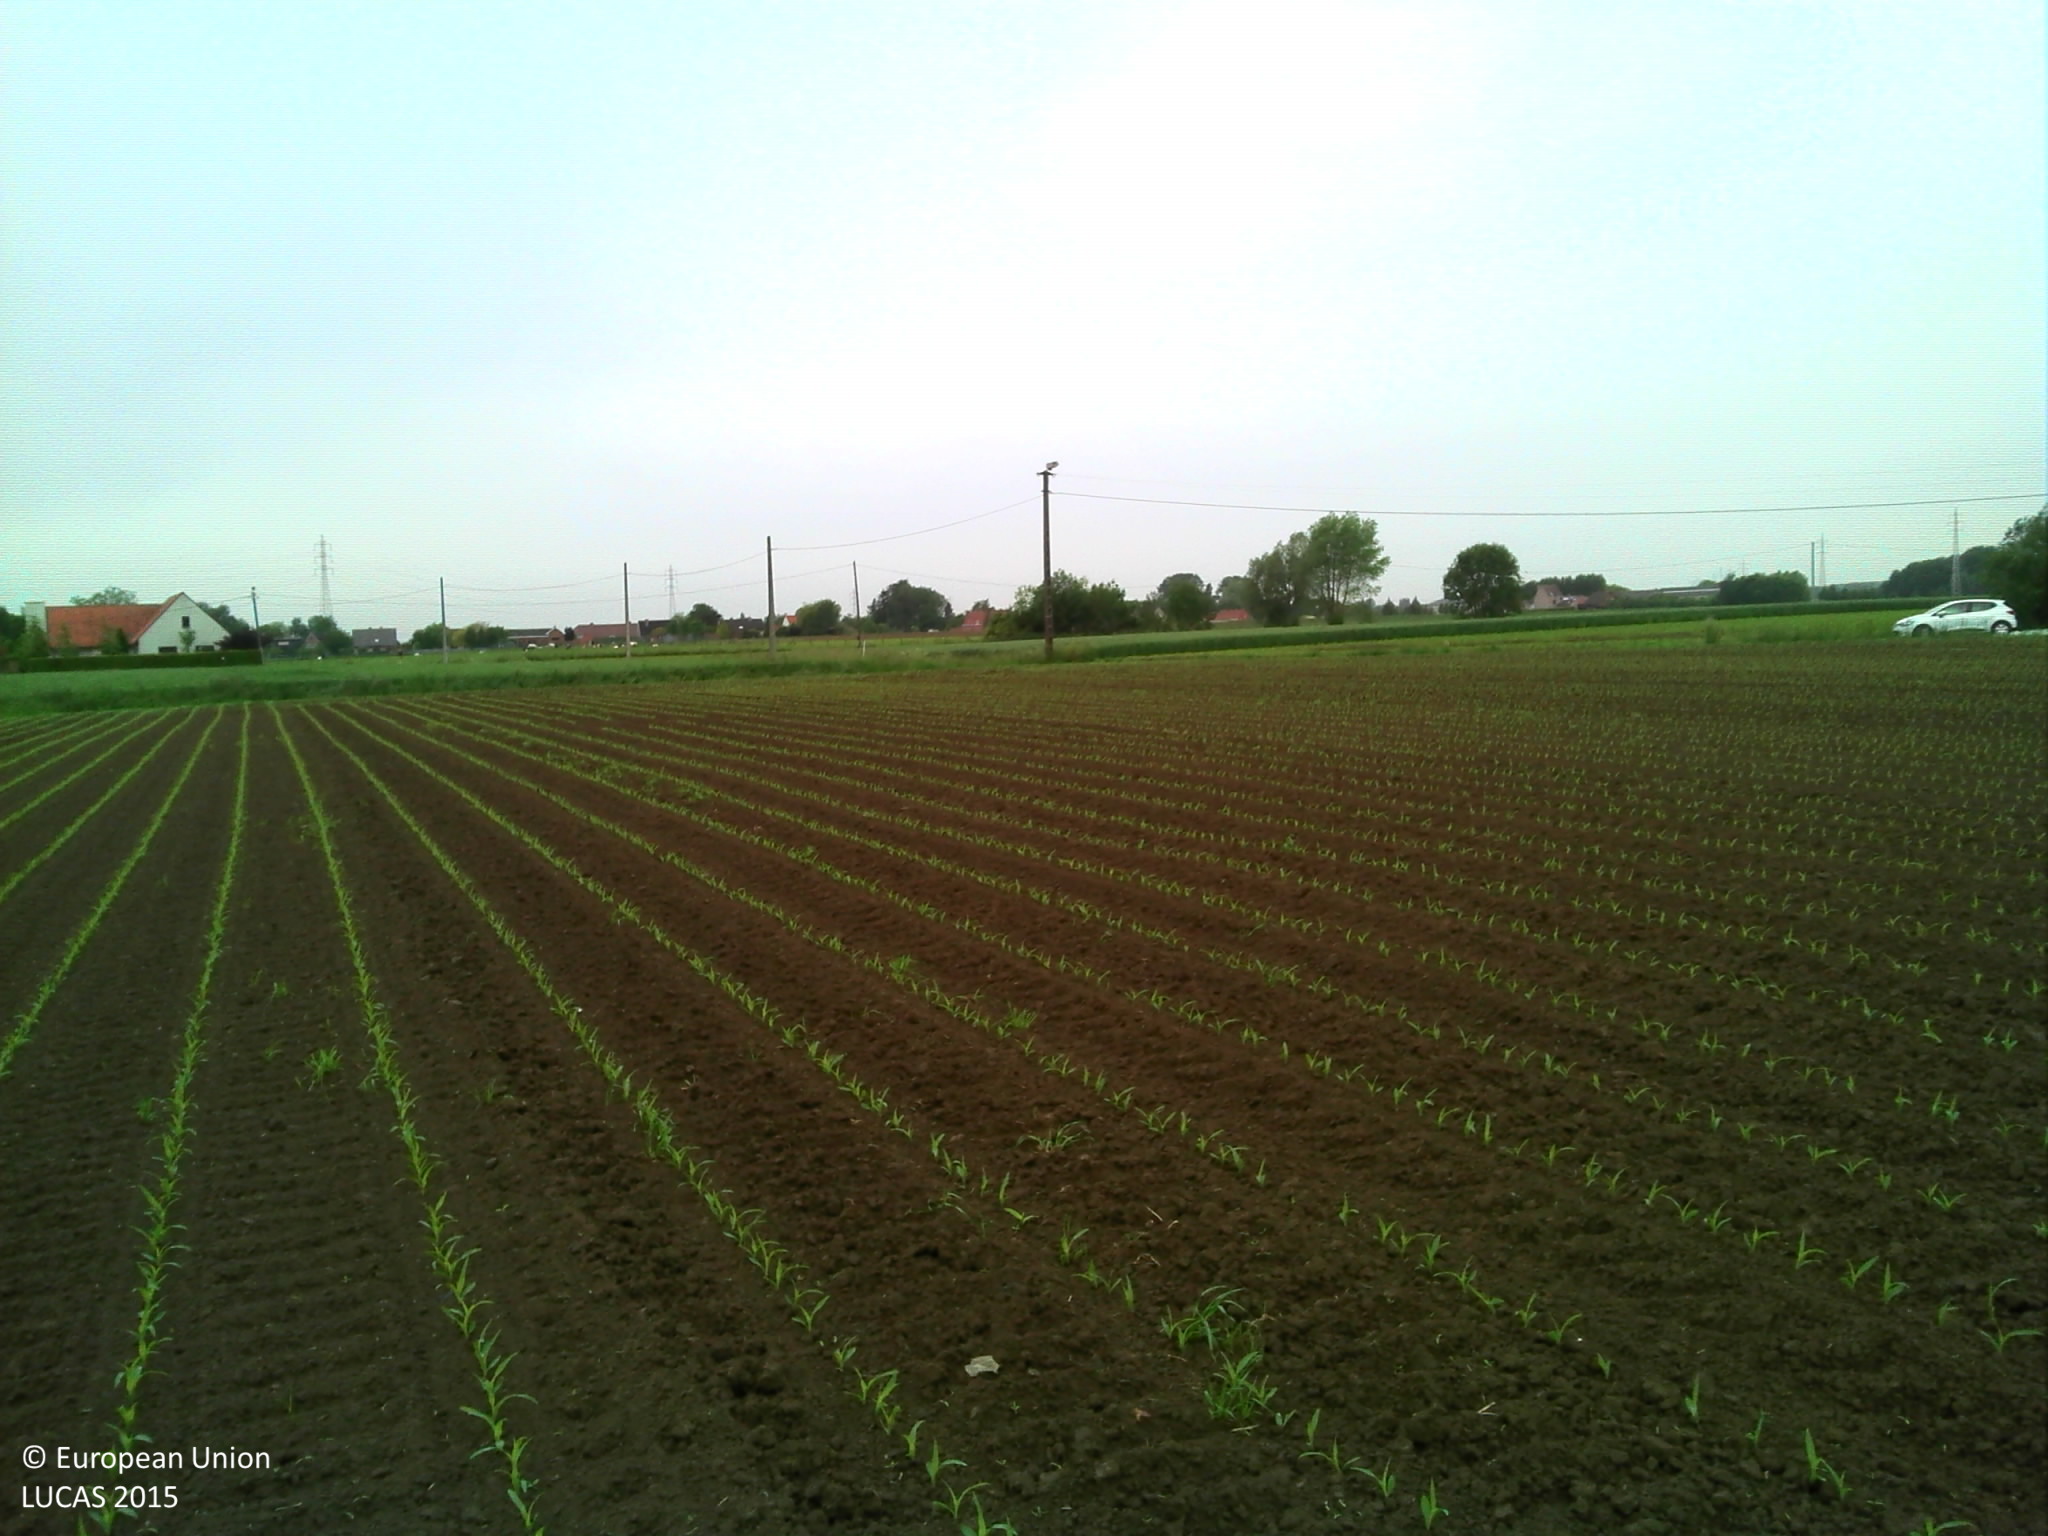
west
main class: Cropland
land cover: Maize
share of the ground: < 10 %
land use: Agriculture (excluding fallow land and kitchen gardens)
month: June
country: BE
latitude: 50.7898
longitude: 3.4525
